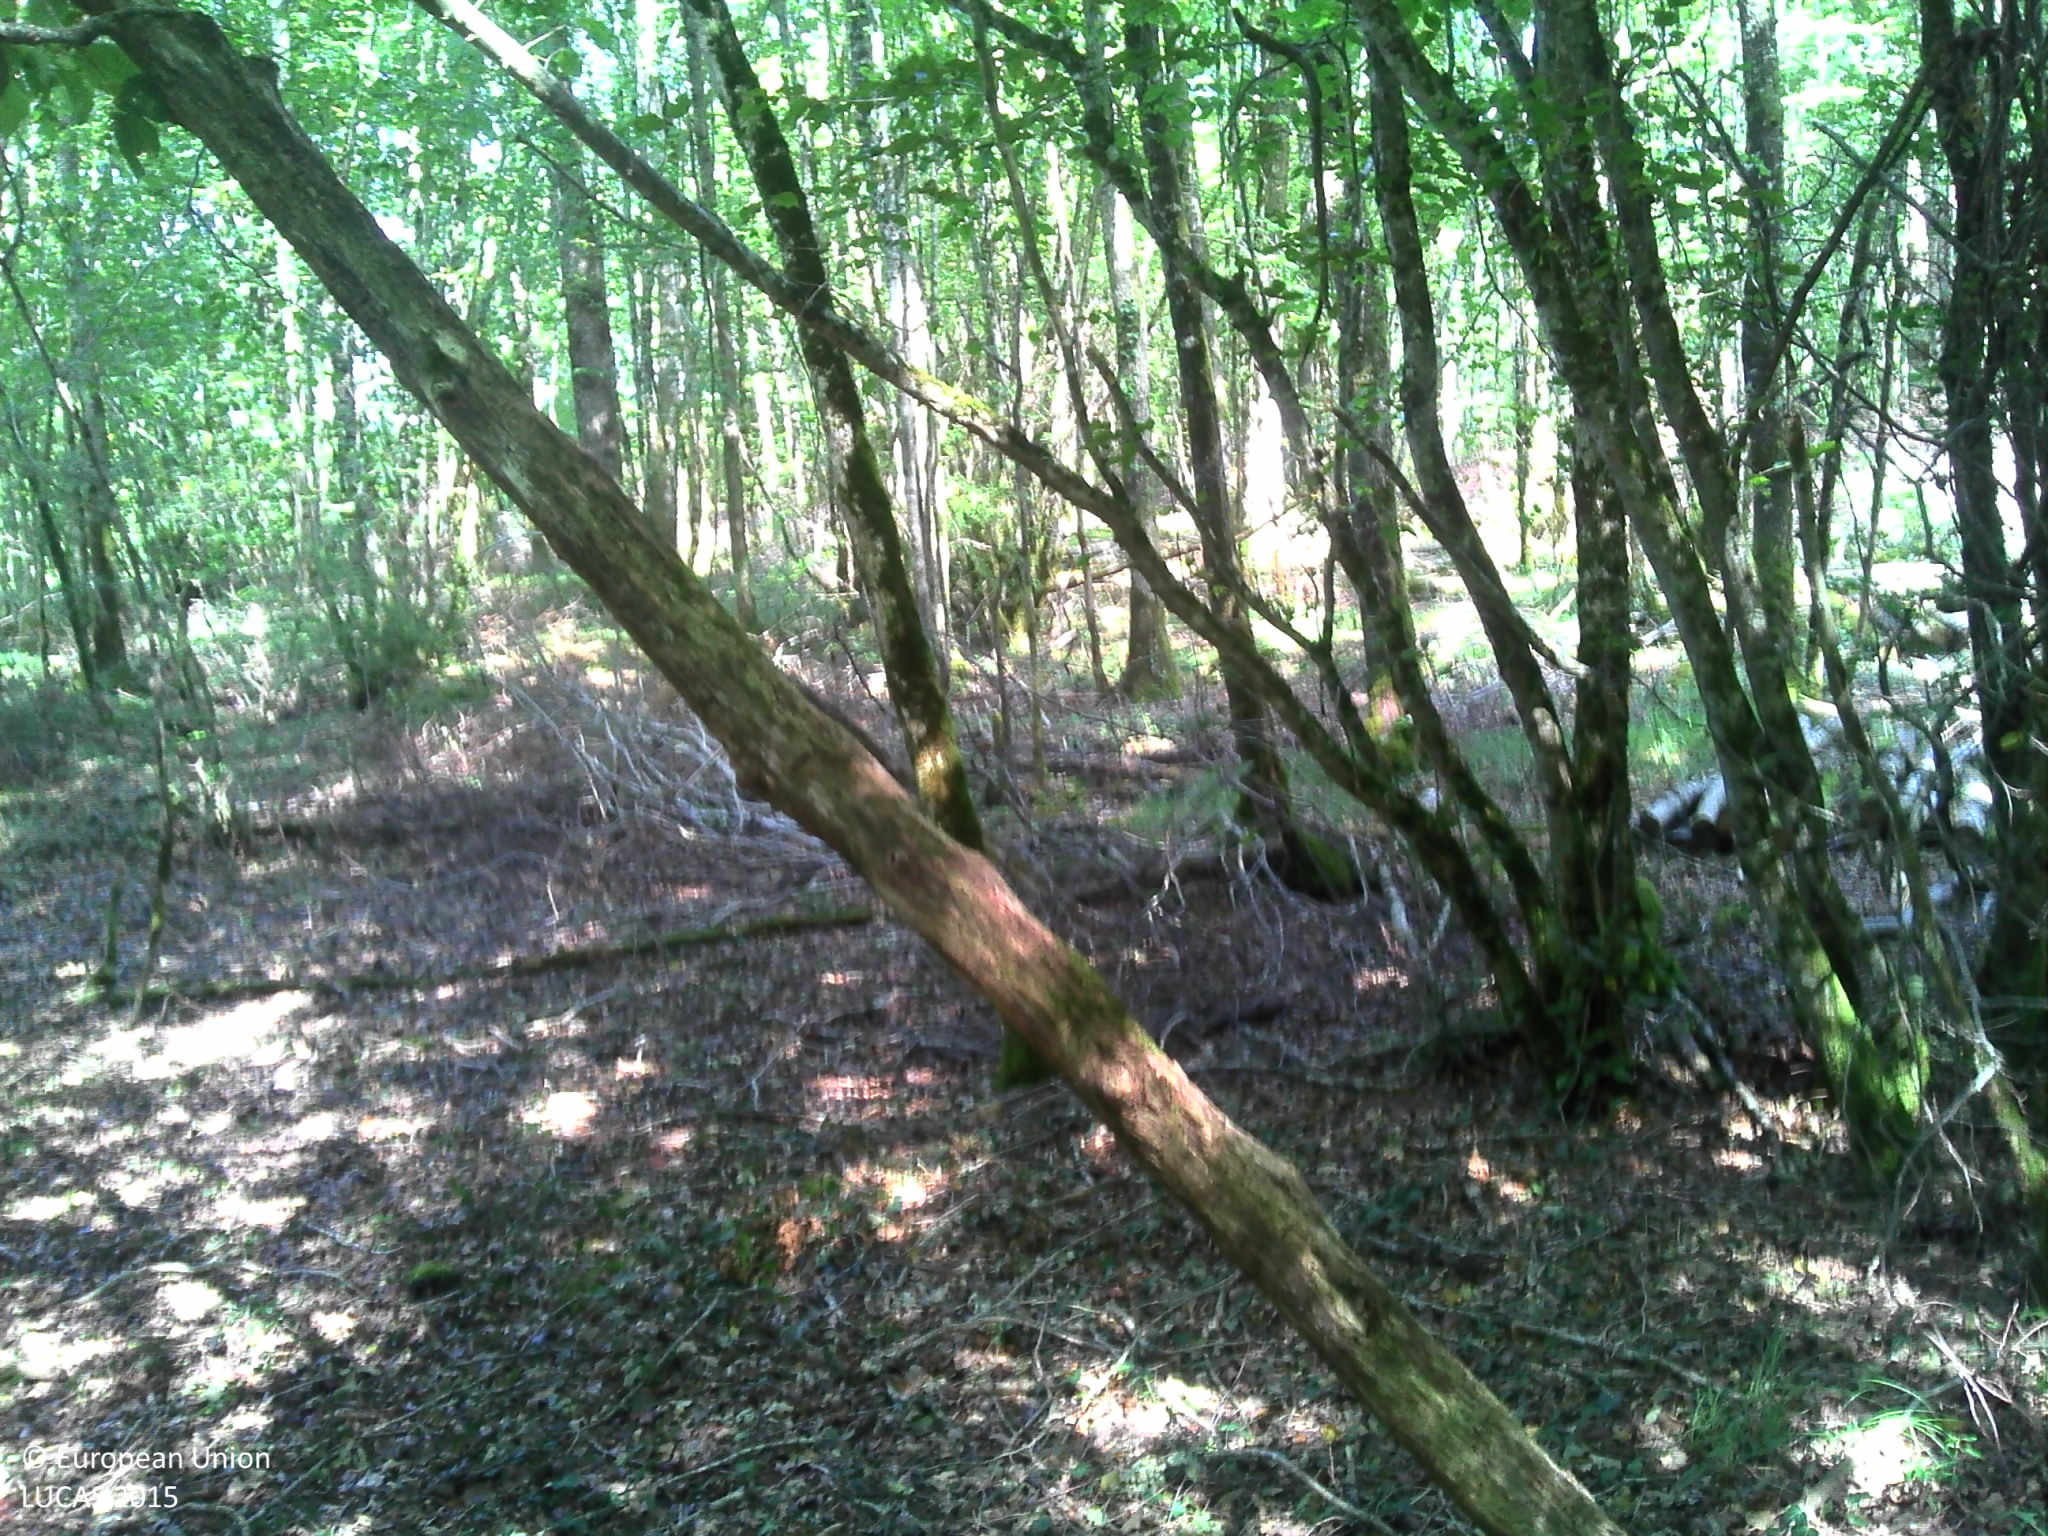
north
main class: Woodland
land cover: Broadleaved woodland
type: mesophytic deciduous forest
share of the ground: > 75 %
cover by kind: broadleaved forest trees 90 %, herbaceous plants 10 %
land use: Forestry
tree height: > 5 m
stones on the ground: < 10 %
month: September
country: FR
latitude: 46.7898
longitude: 1.4867
